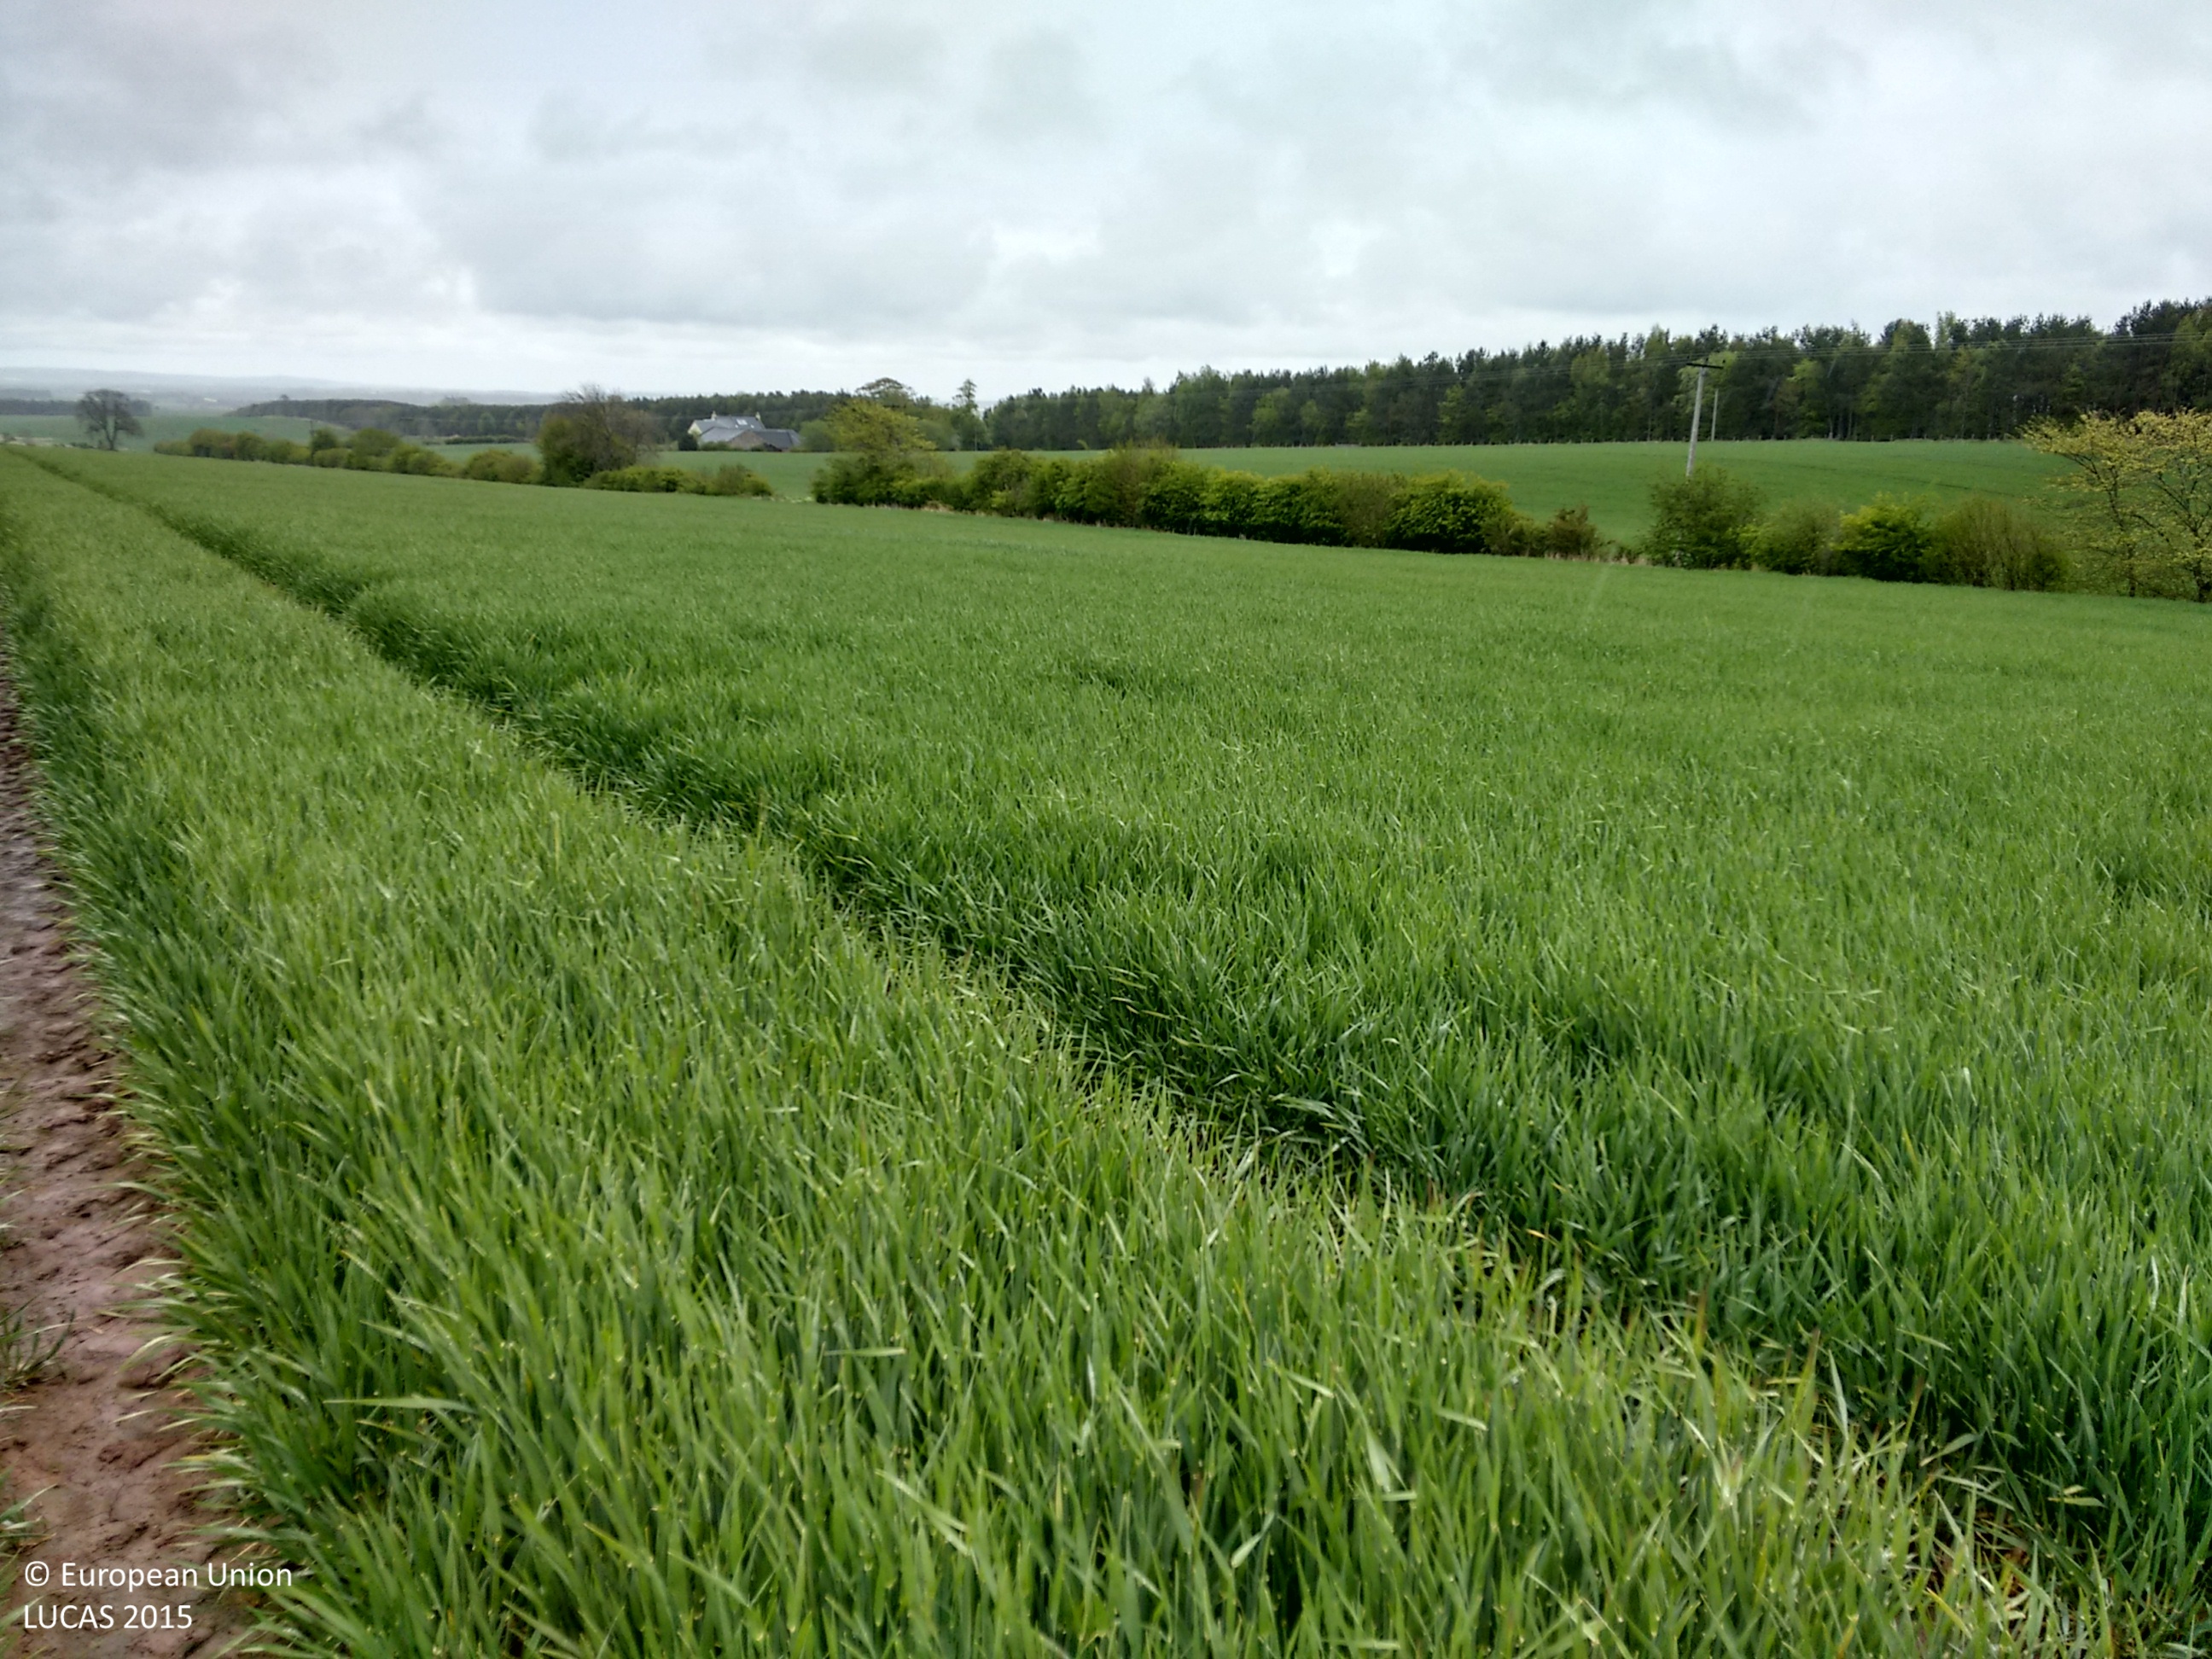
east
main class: Cropland
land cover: Barley
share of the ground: > 75 %
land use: Agriculture (excluding fallow land and kitchen gardens)
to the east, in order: Barley; Grass margins; Lines of trees
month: May
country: GB
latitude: 55.7469
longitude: -2.4048
